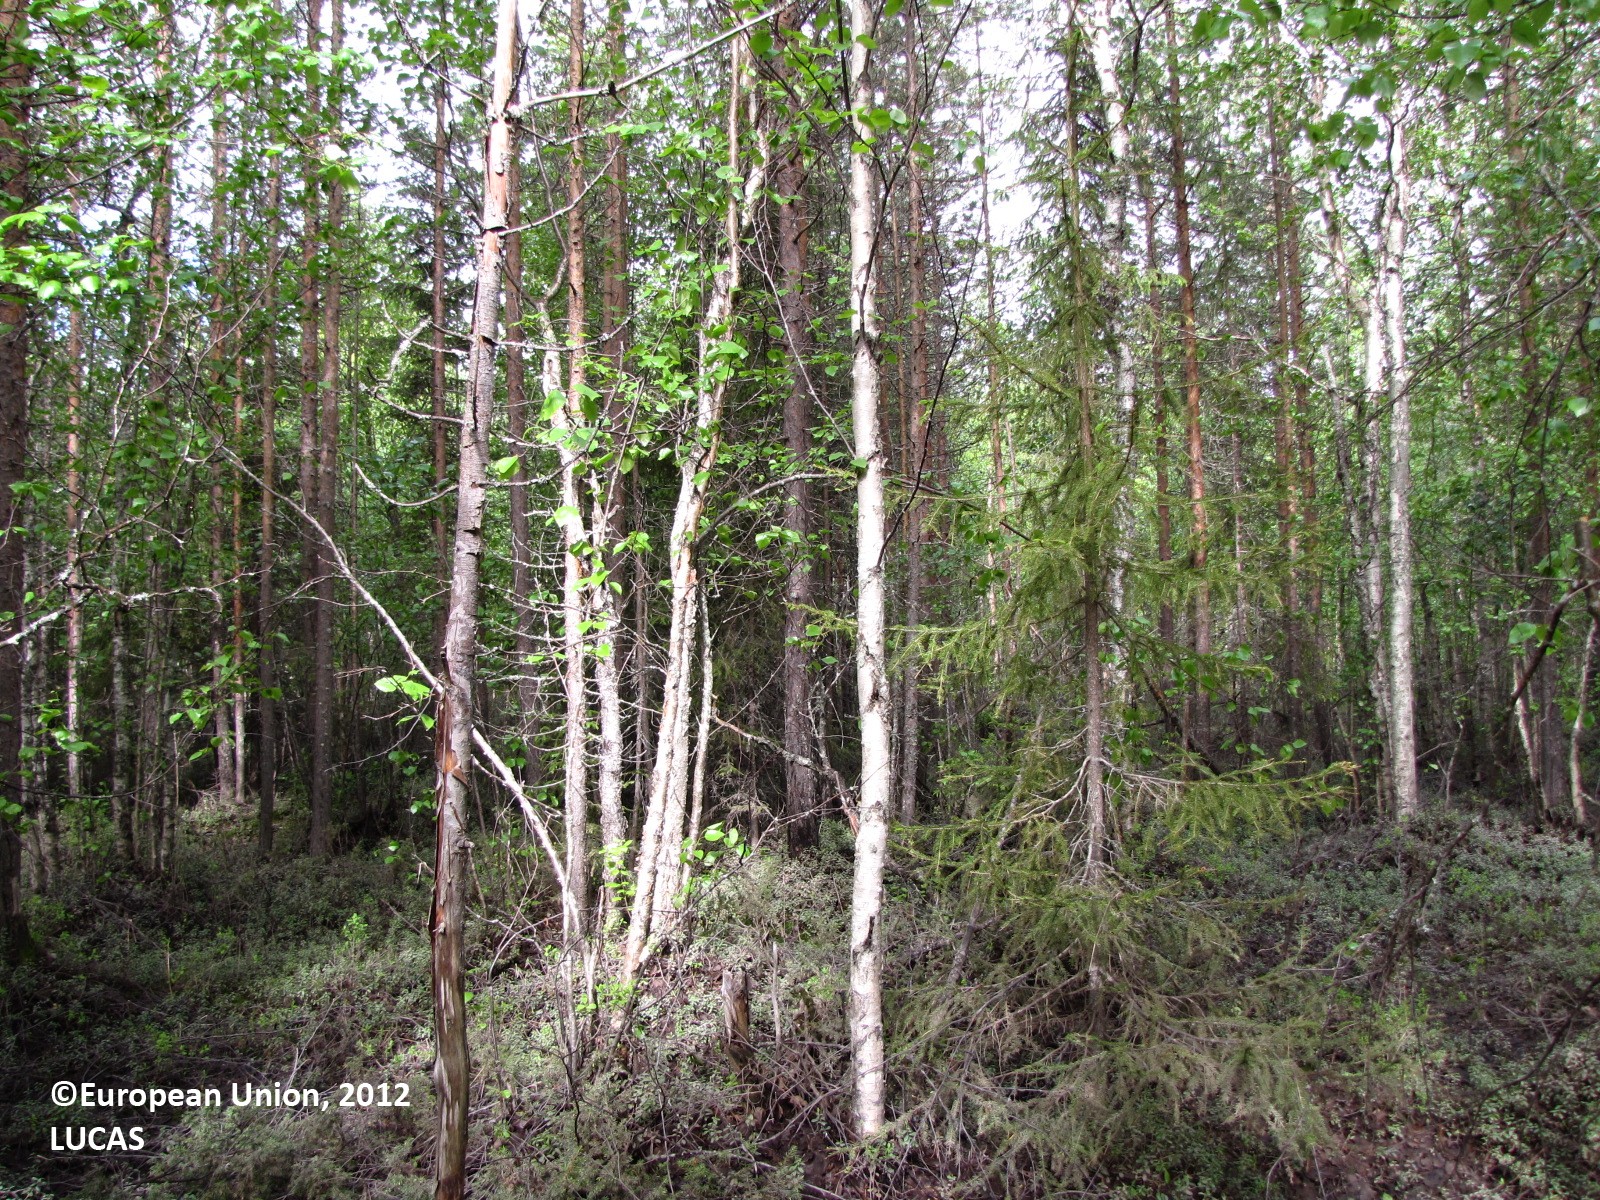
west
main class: Woodland
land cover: Pine dominated mixed woodland
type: boreal forest
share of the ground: 50 - 75 %
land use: Forestry
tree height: > 5 m
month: June
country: FI
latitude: 66.4723
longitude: 24.3423
